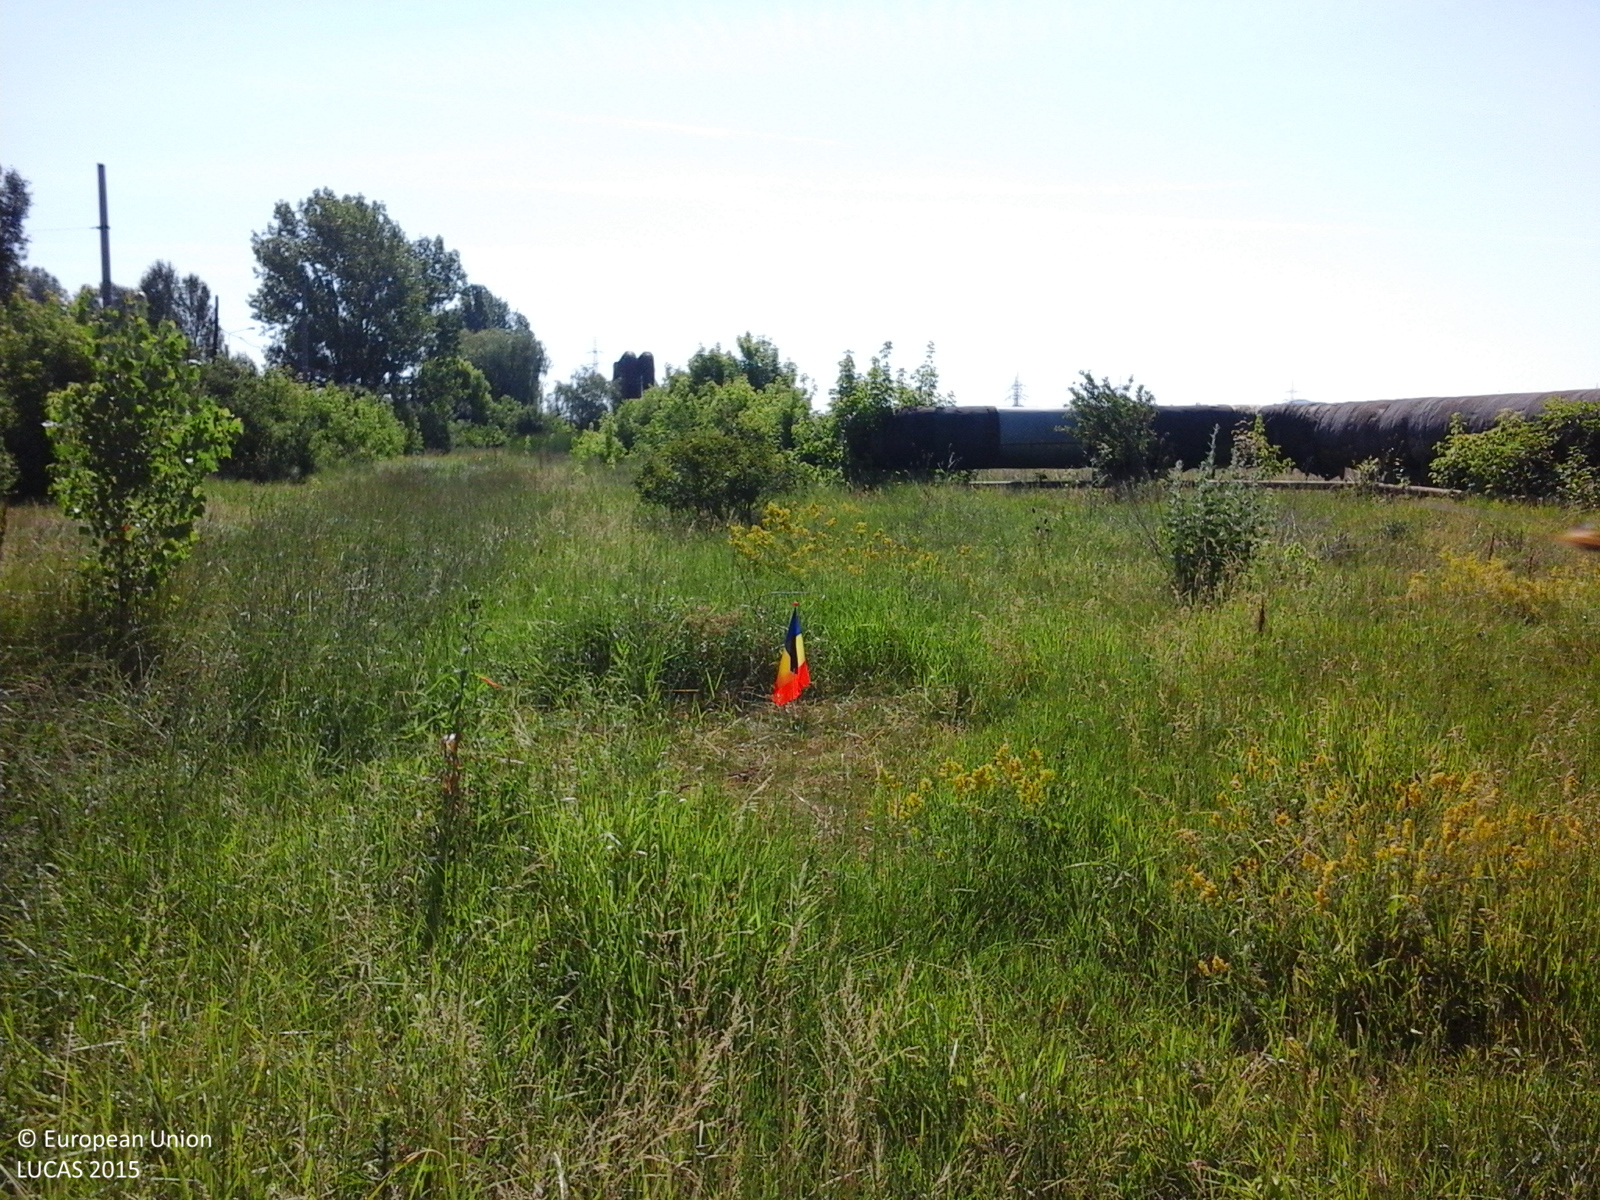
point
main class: Grassland
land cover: Grassland with sparse tree/shrub cover
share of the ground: > 75 %
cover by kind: herbaceous plants 90 %, broadleaved forest trees 5 %, shrubs 5 %
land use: Semi-natural and natural areas not in use
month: June
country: RO
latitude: 47.1527
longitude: 27.6481
